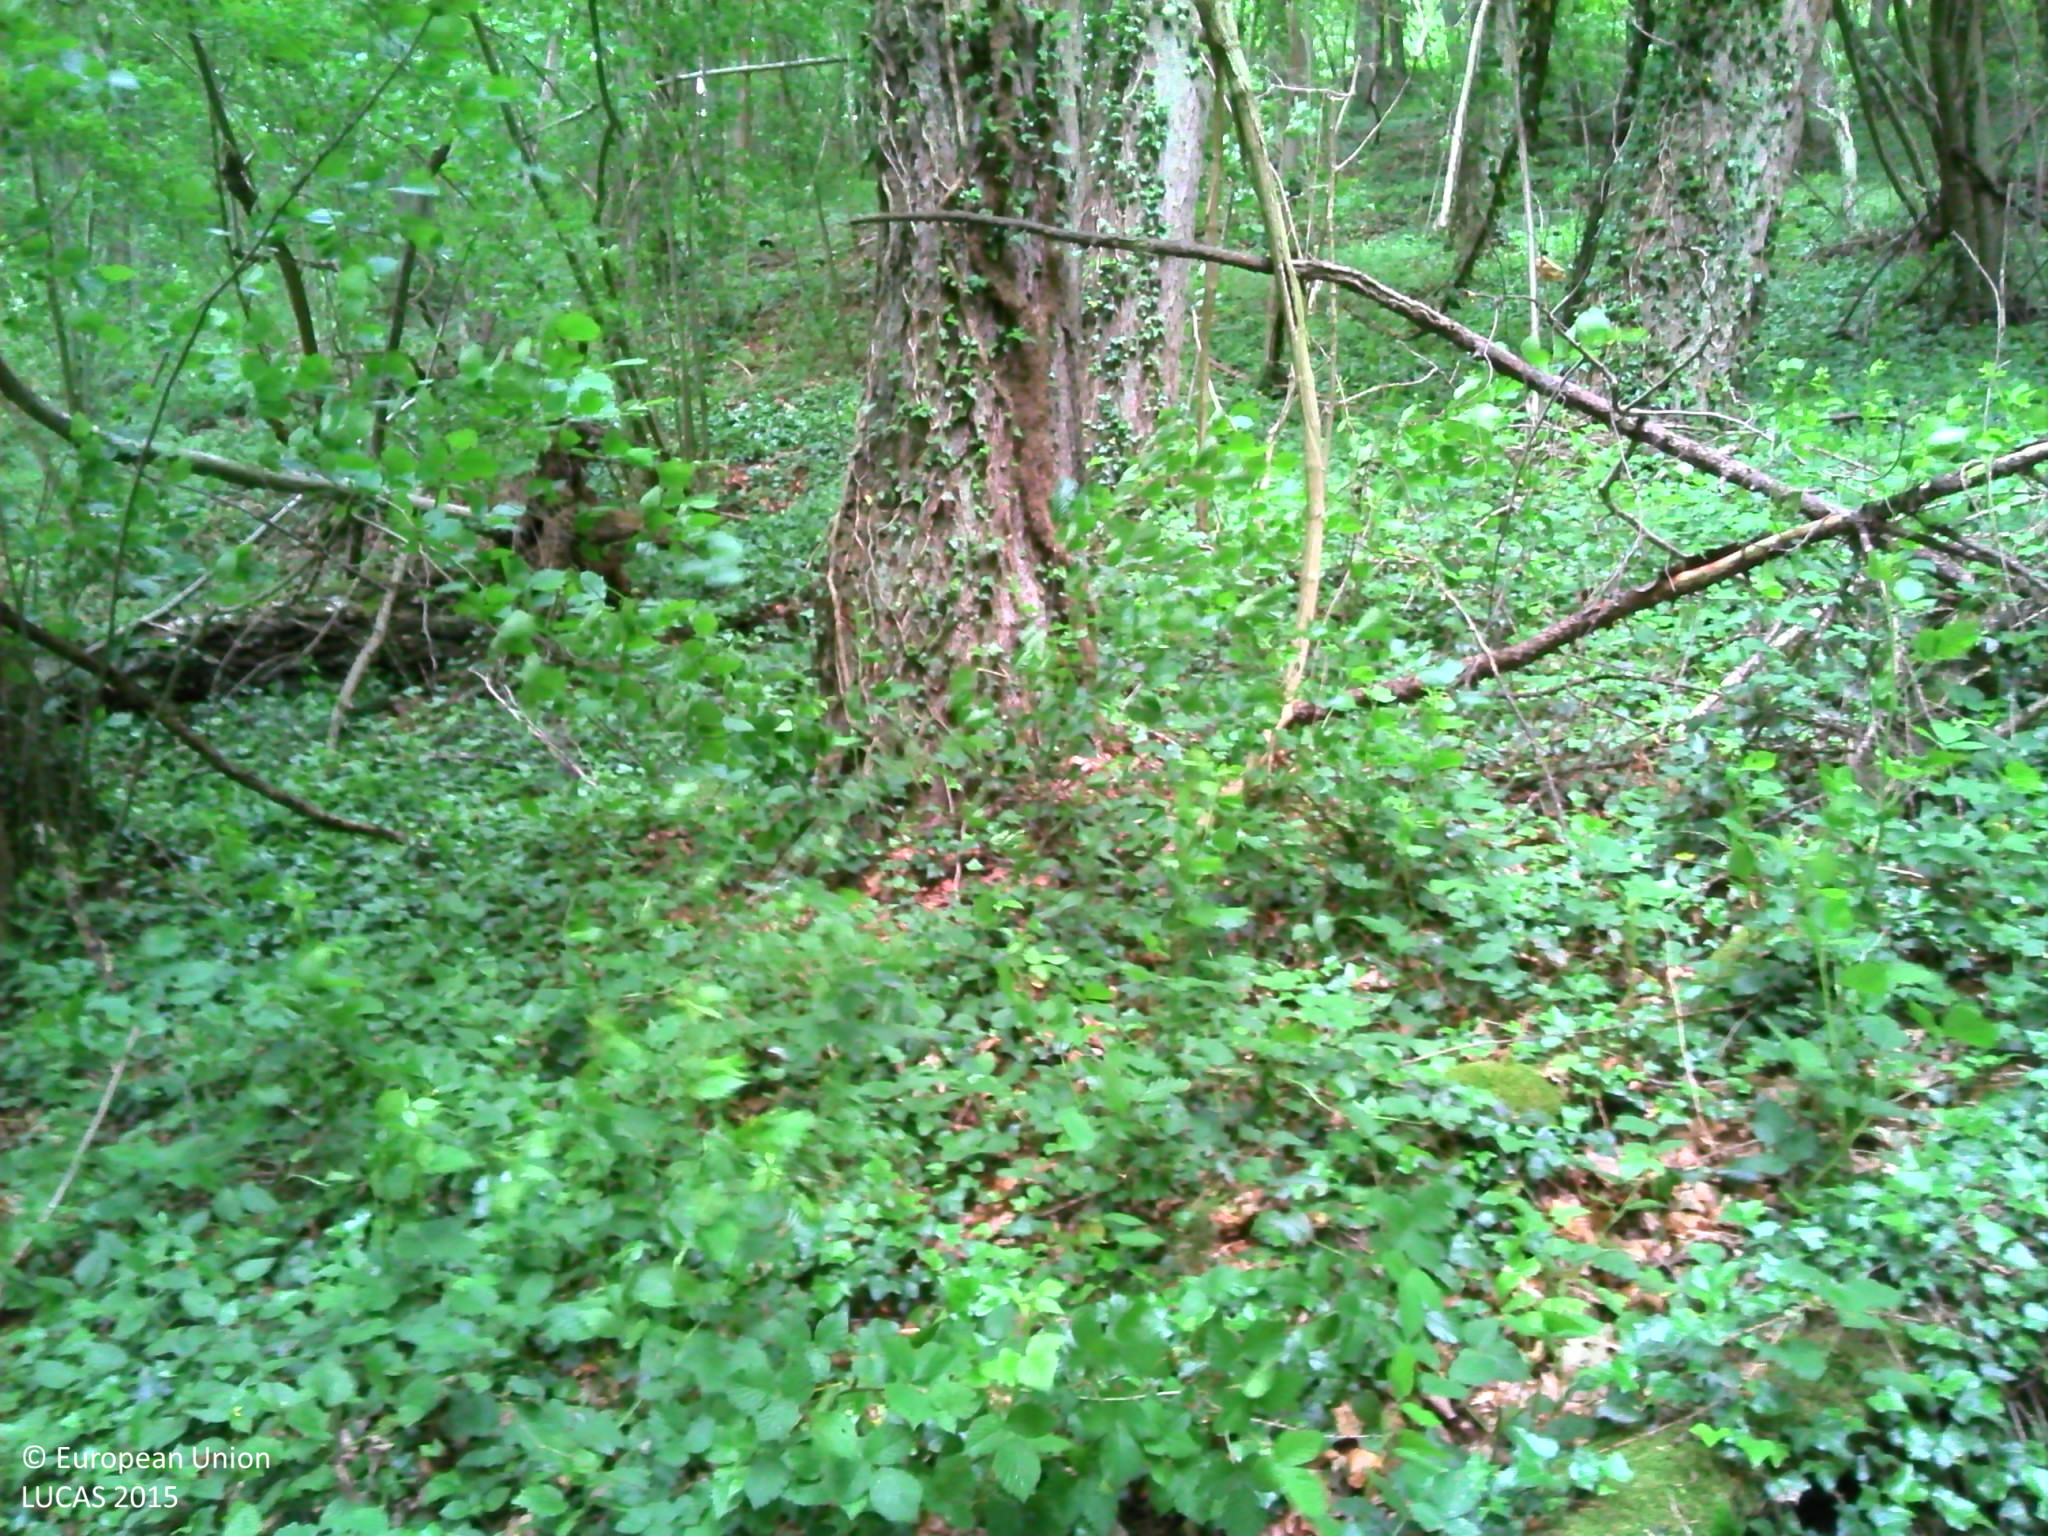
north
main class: Woodland
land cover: Broadleaved woodland
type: acidophilous oak and oak-birch forest
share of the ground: > 75 %
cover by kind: broadleaved forest trees 90 %, herbaceous plants 10 %
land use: Forestry
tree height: > 5 m
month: June
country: BE
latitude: 50.4031
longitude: 5.5383
